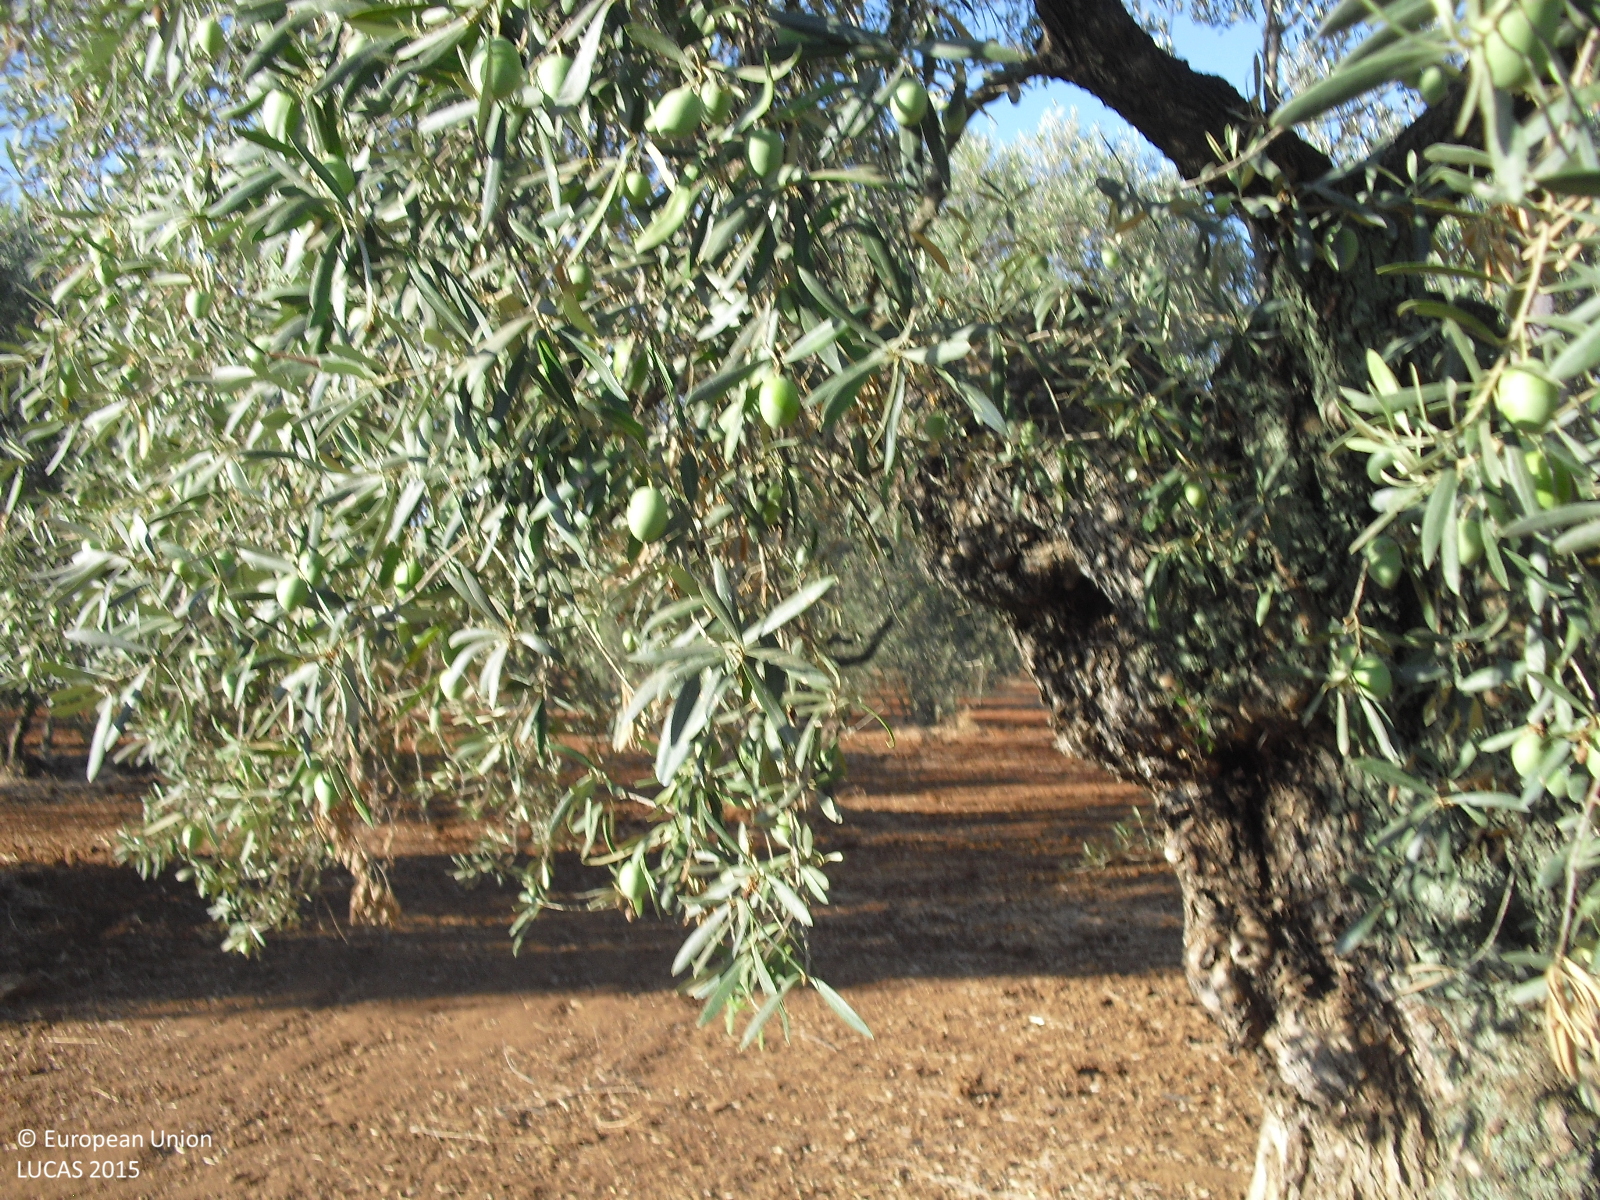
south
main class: Cropland
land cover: Olive groves
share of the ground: 25 - 50 %
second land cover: Other bare soil
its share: > 75 %
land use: Agriculture (excluding fallow land and kitchen gardens)
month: August
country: ES
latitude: 37.2007
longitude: -5.5271
